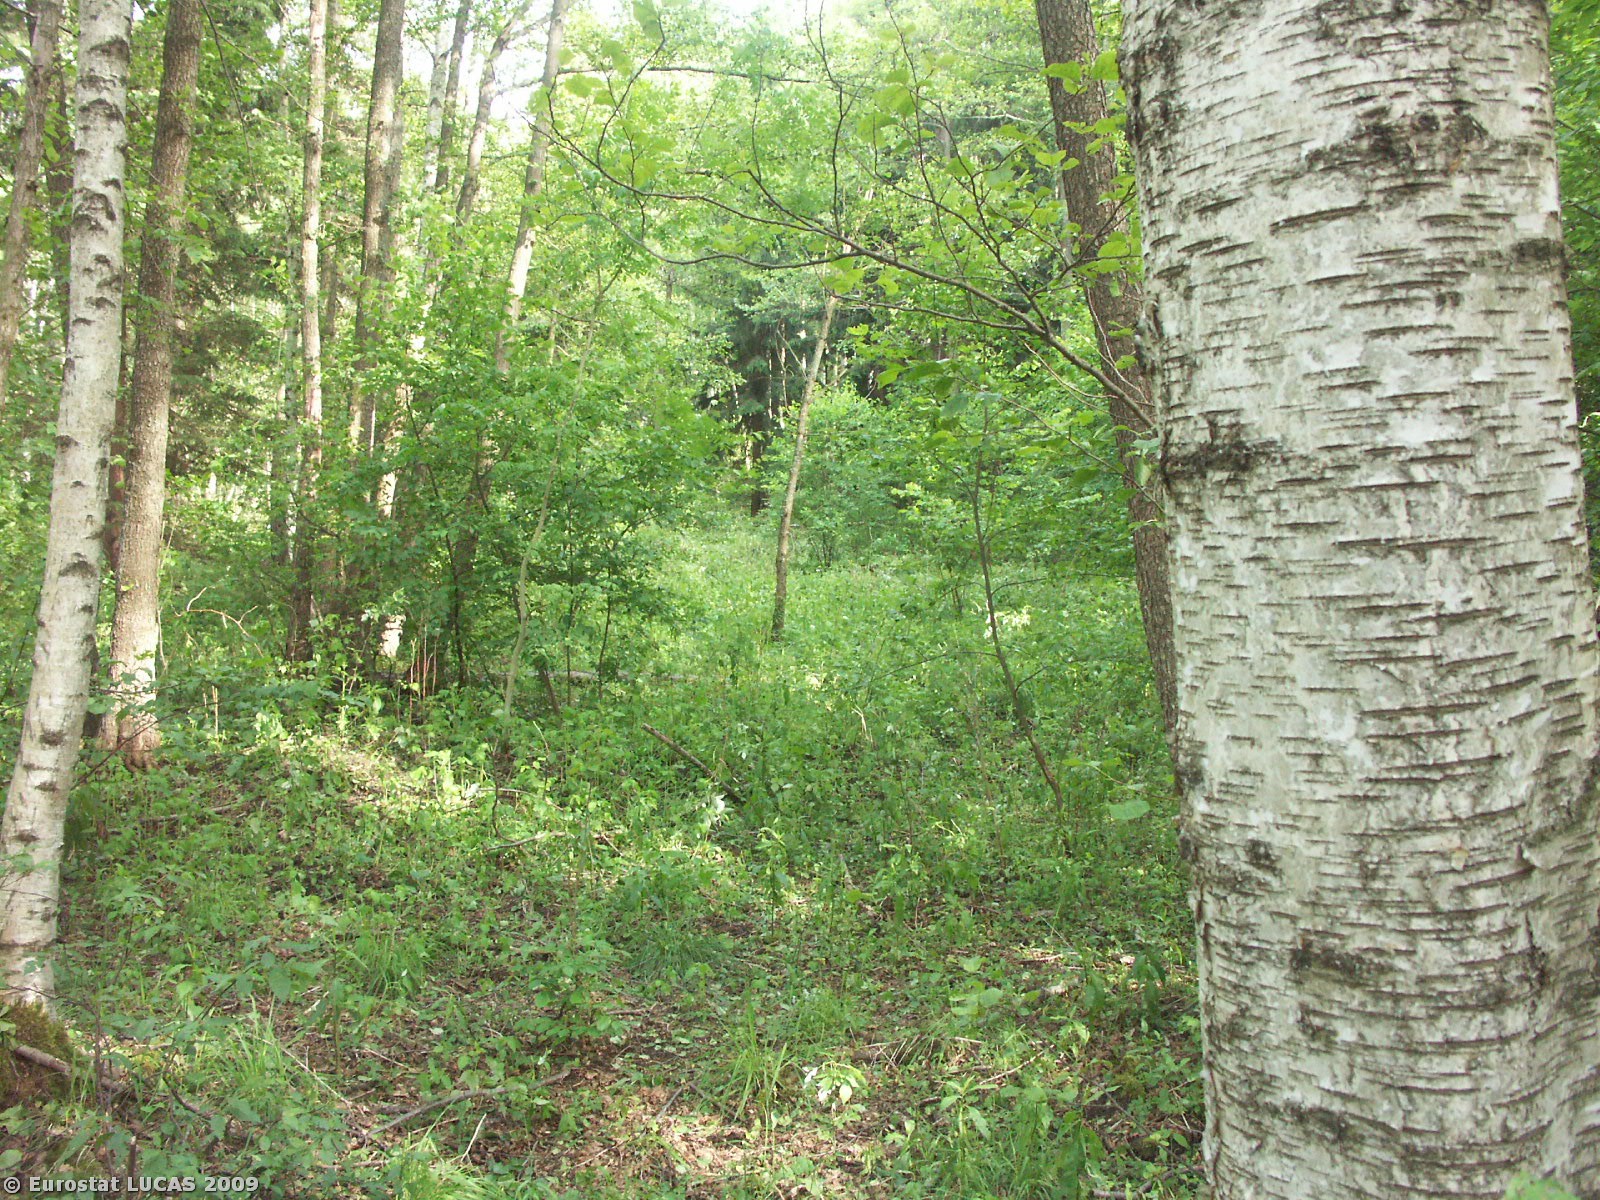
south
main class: Woodland
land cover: Broadleaved woodland
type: non-riverine alder, birch or aspen forest
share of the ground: > 75 %
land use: Forestry
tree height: > 5 m
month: May
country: CZ
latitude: 48.9396
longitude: 14.1099
